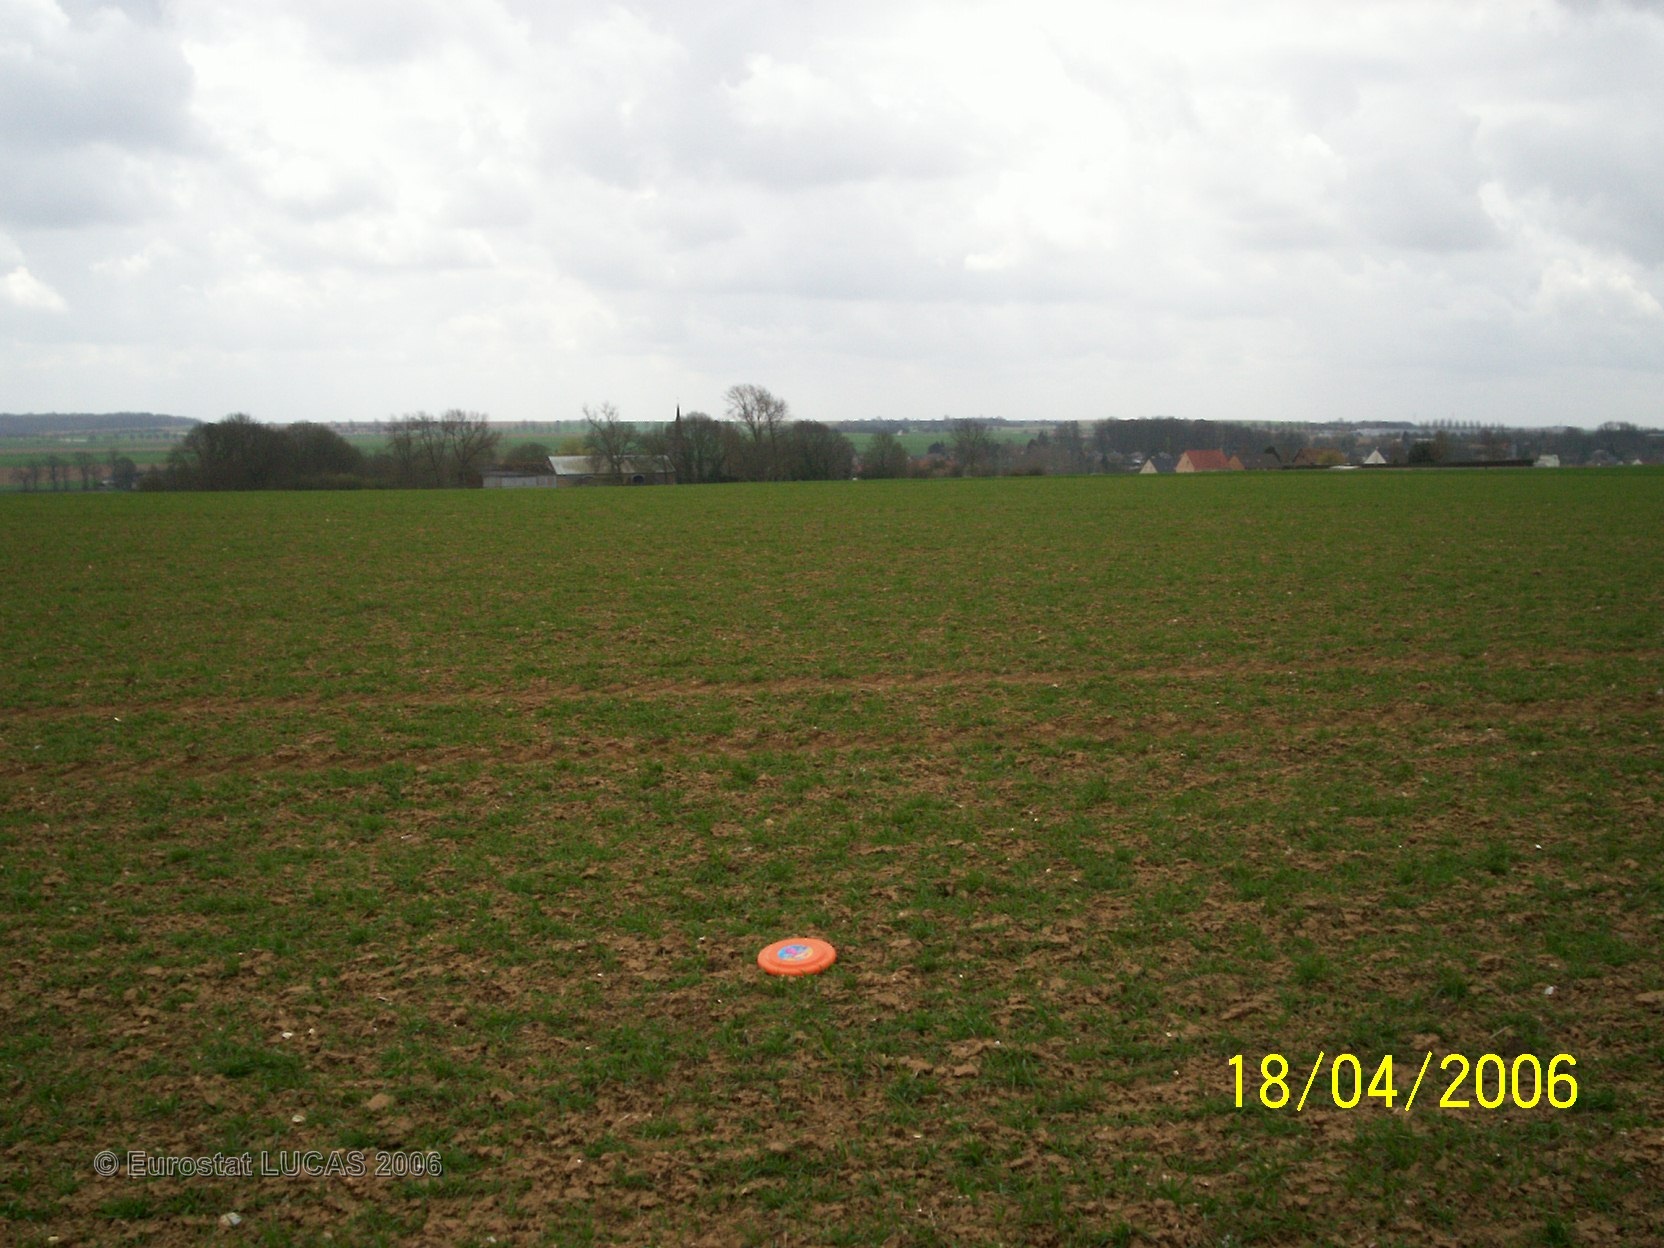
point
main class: Cropland
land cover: Common wheat
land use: Agriculture (excluding fallow land and kitchen gardens)
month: April
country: FR
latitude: 50.3595
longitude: 2.6083
